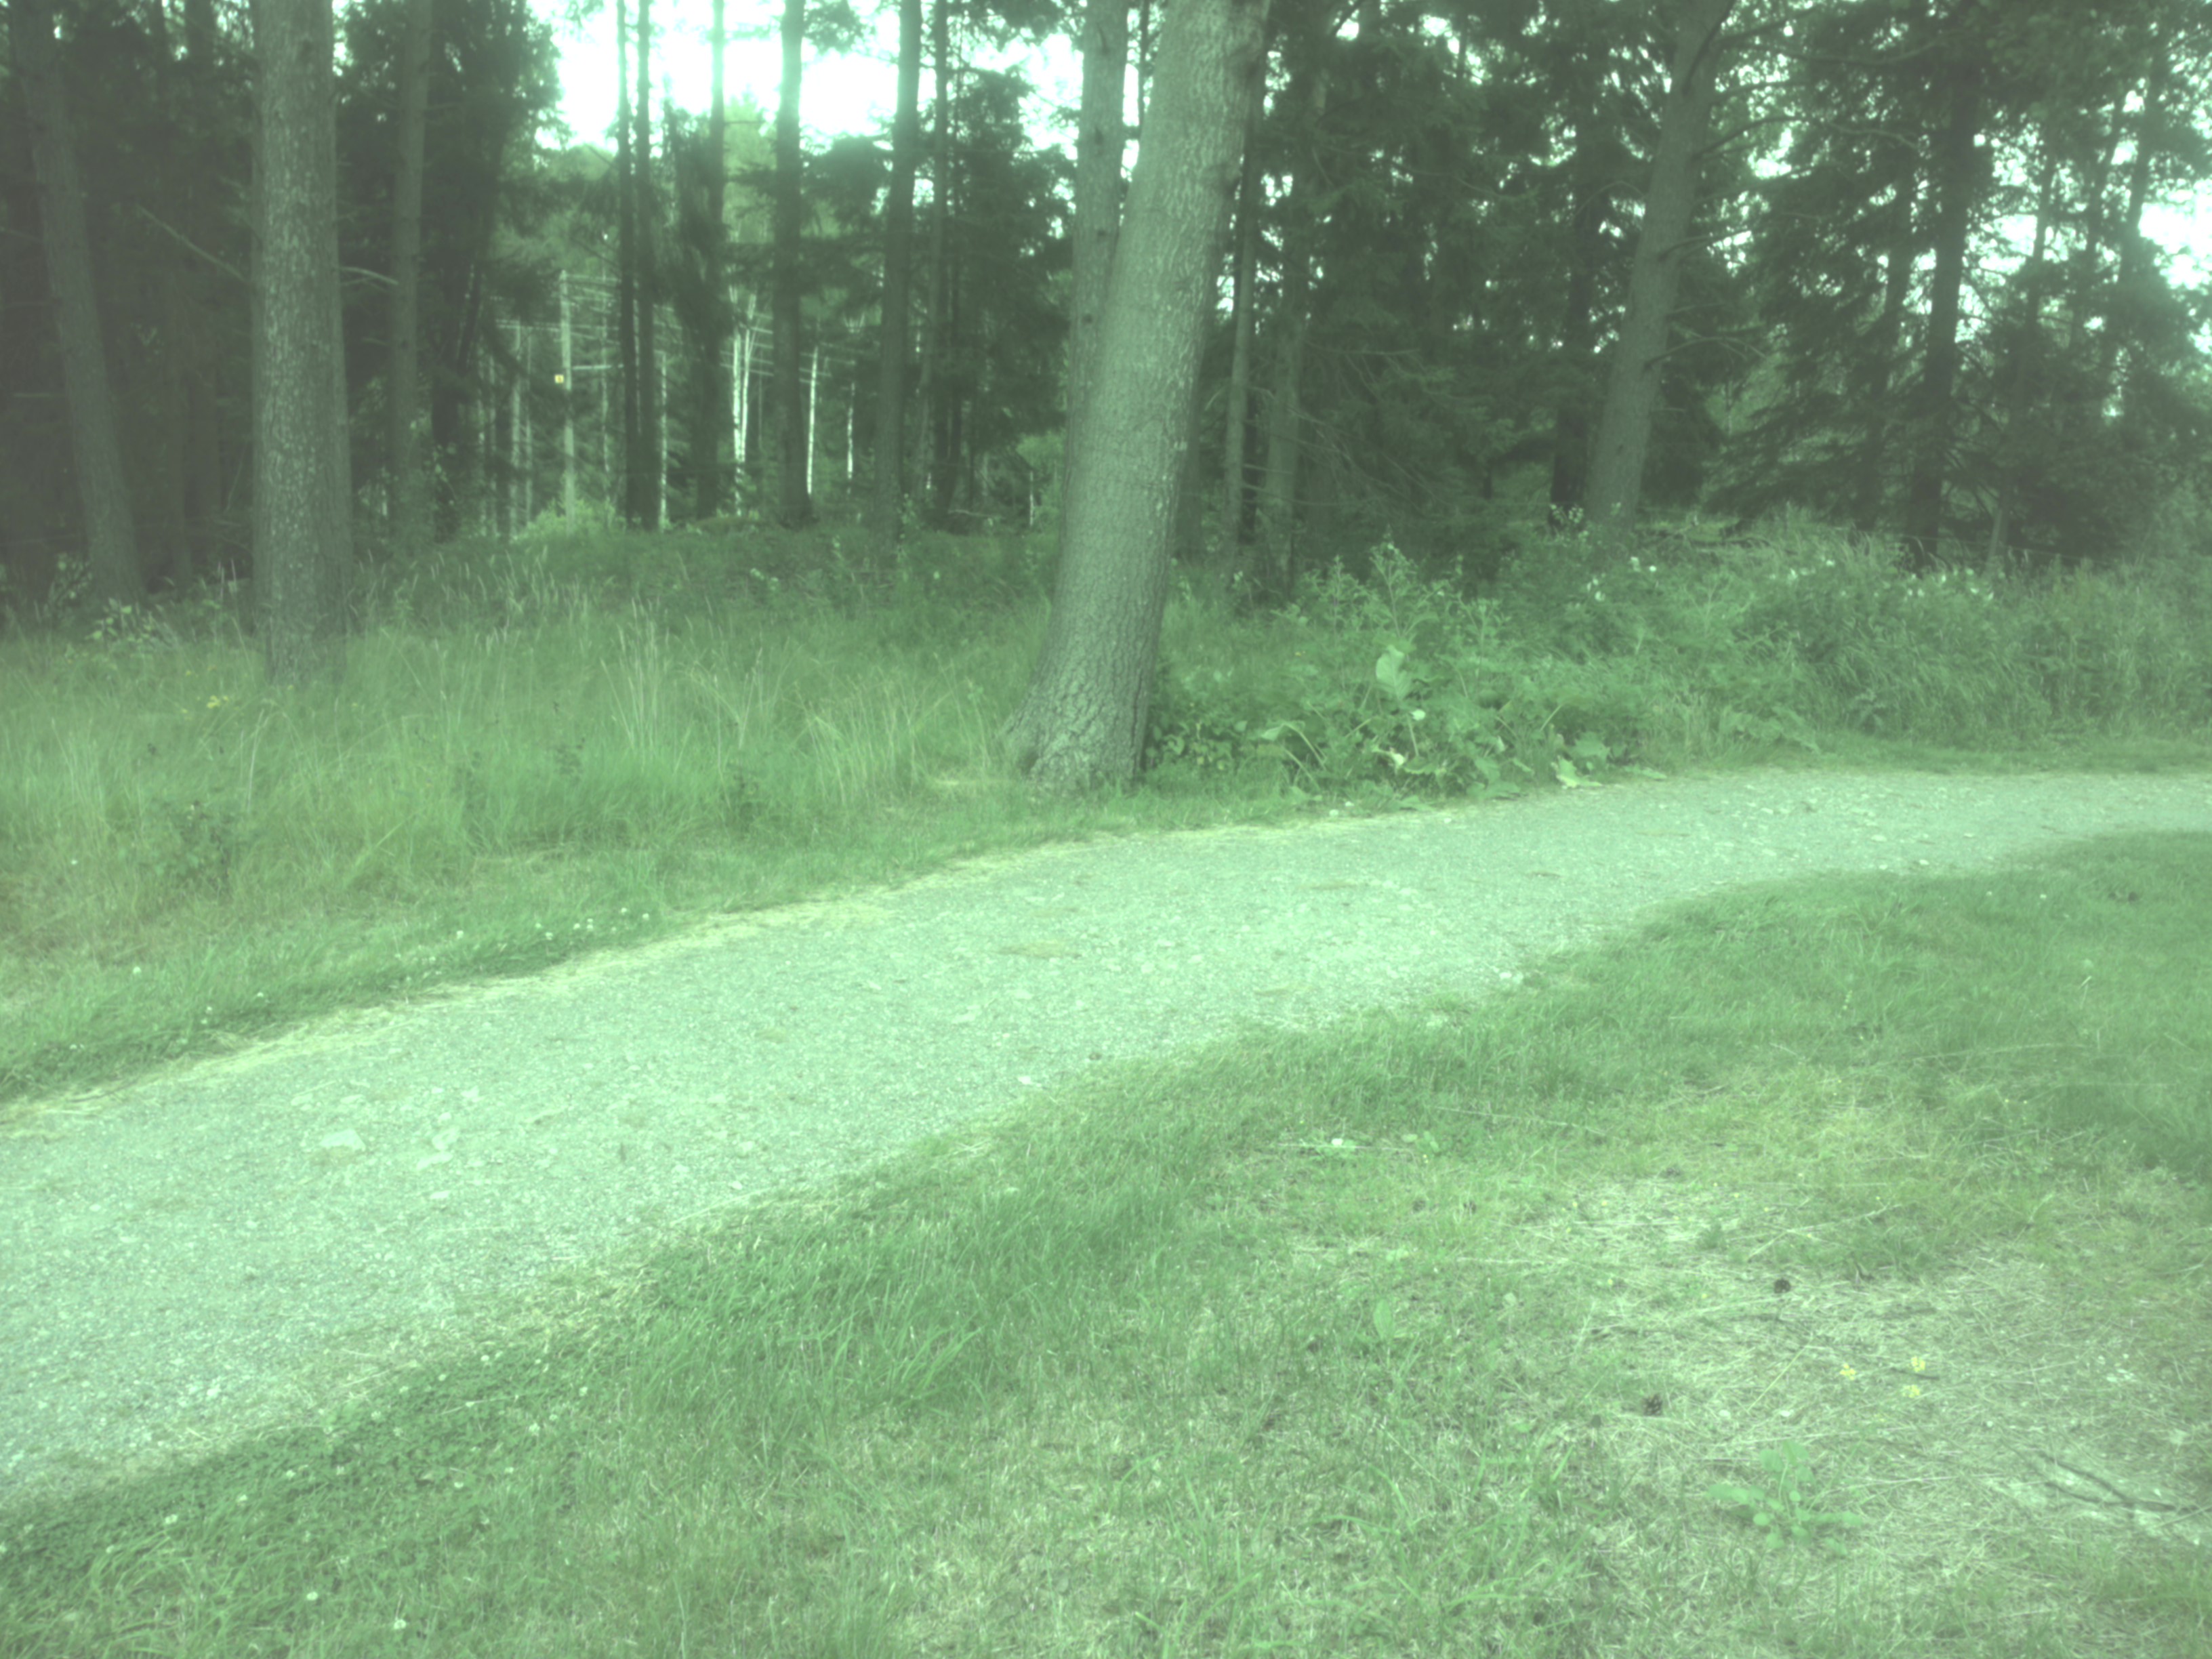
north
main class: Grassland
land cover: Grassland with sparse tree/shrub cover
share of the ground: > 75 %
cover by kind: herbaceous plants 95 %, broadleaved forest trees 5 %
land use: Sport
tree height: > 5 m
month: July
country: SE
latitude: 59.2523
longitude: 18.2242
